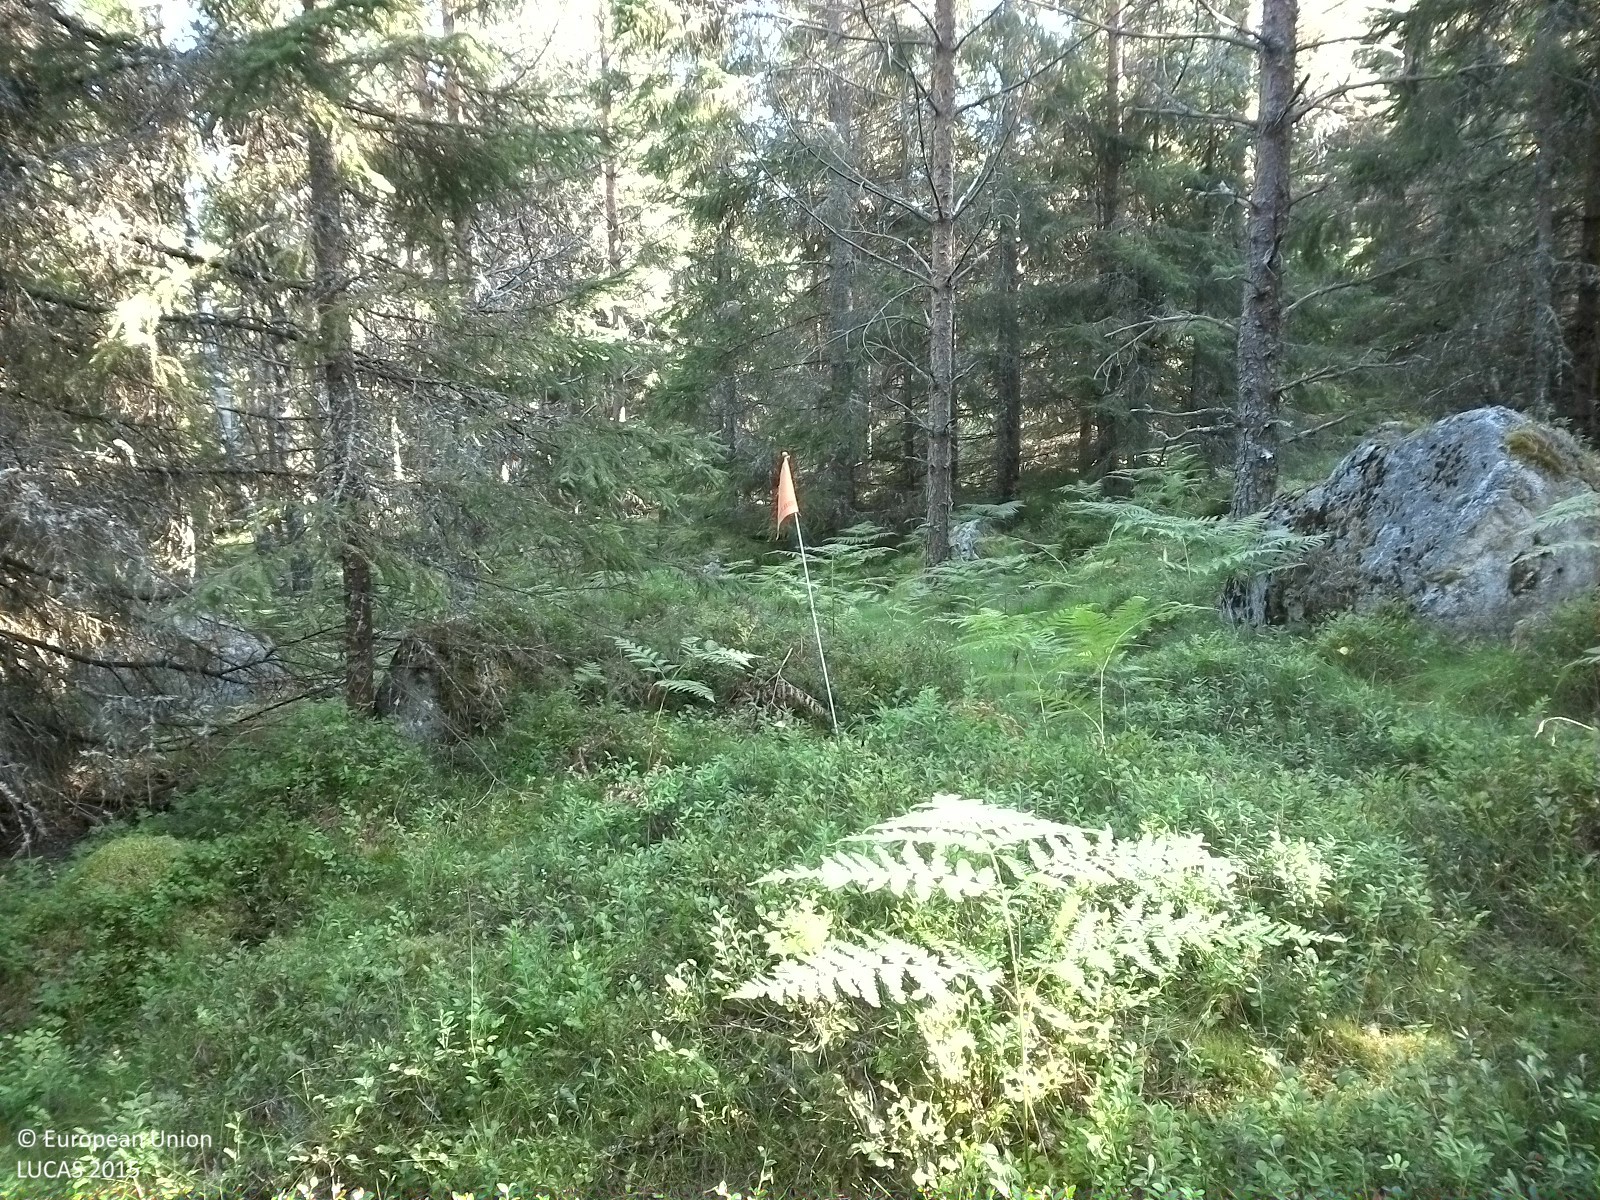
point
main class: Woodland
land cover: Other coniferous woodland
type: boreal forest
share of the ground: 25 - 50 %
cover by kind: herbaceous plants 45 %, coniferous forest trees 40 %, lichens and mosses 15 %
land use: Forestry
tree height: > 5 m
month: August
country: SE
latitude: 59.2199
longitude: 14.6693
